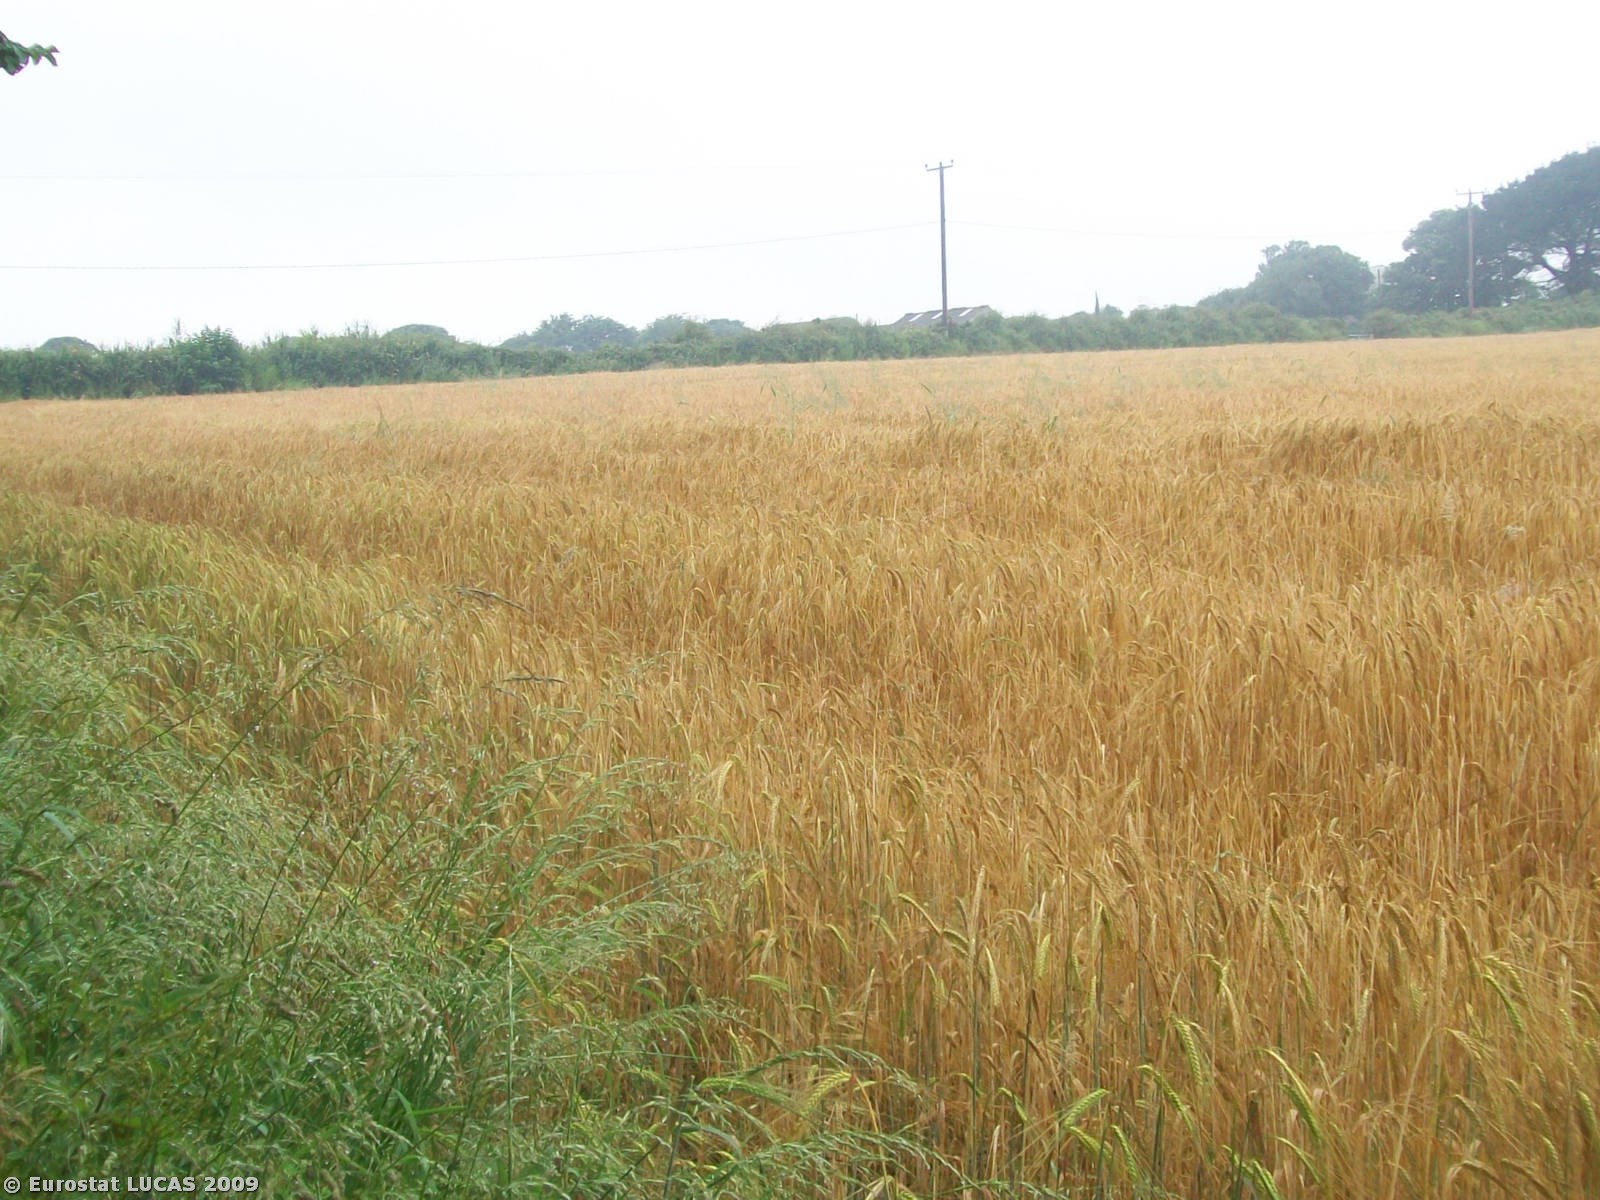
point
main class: Cropland
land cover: Barley
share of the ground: > 75 %
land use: Agriculture (excluding fallow land and kitchen gardens)
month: July
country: GB
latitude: 50.2880
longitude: -5.0936
